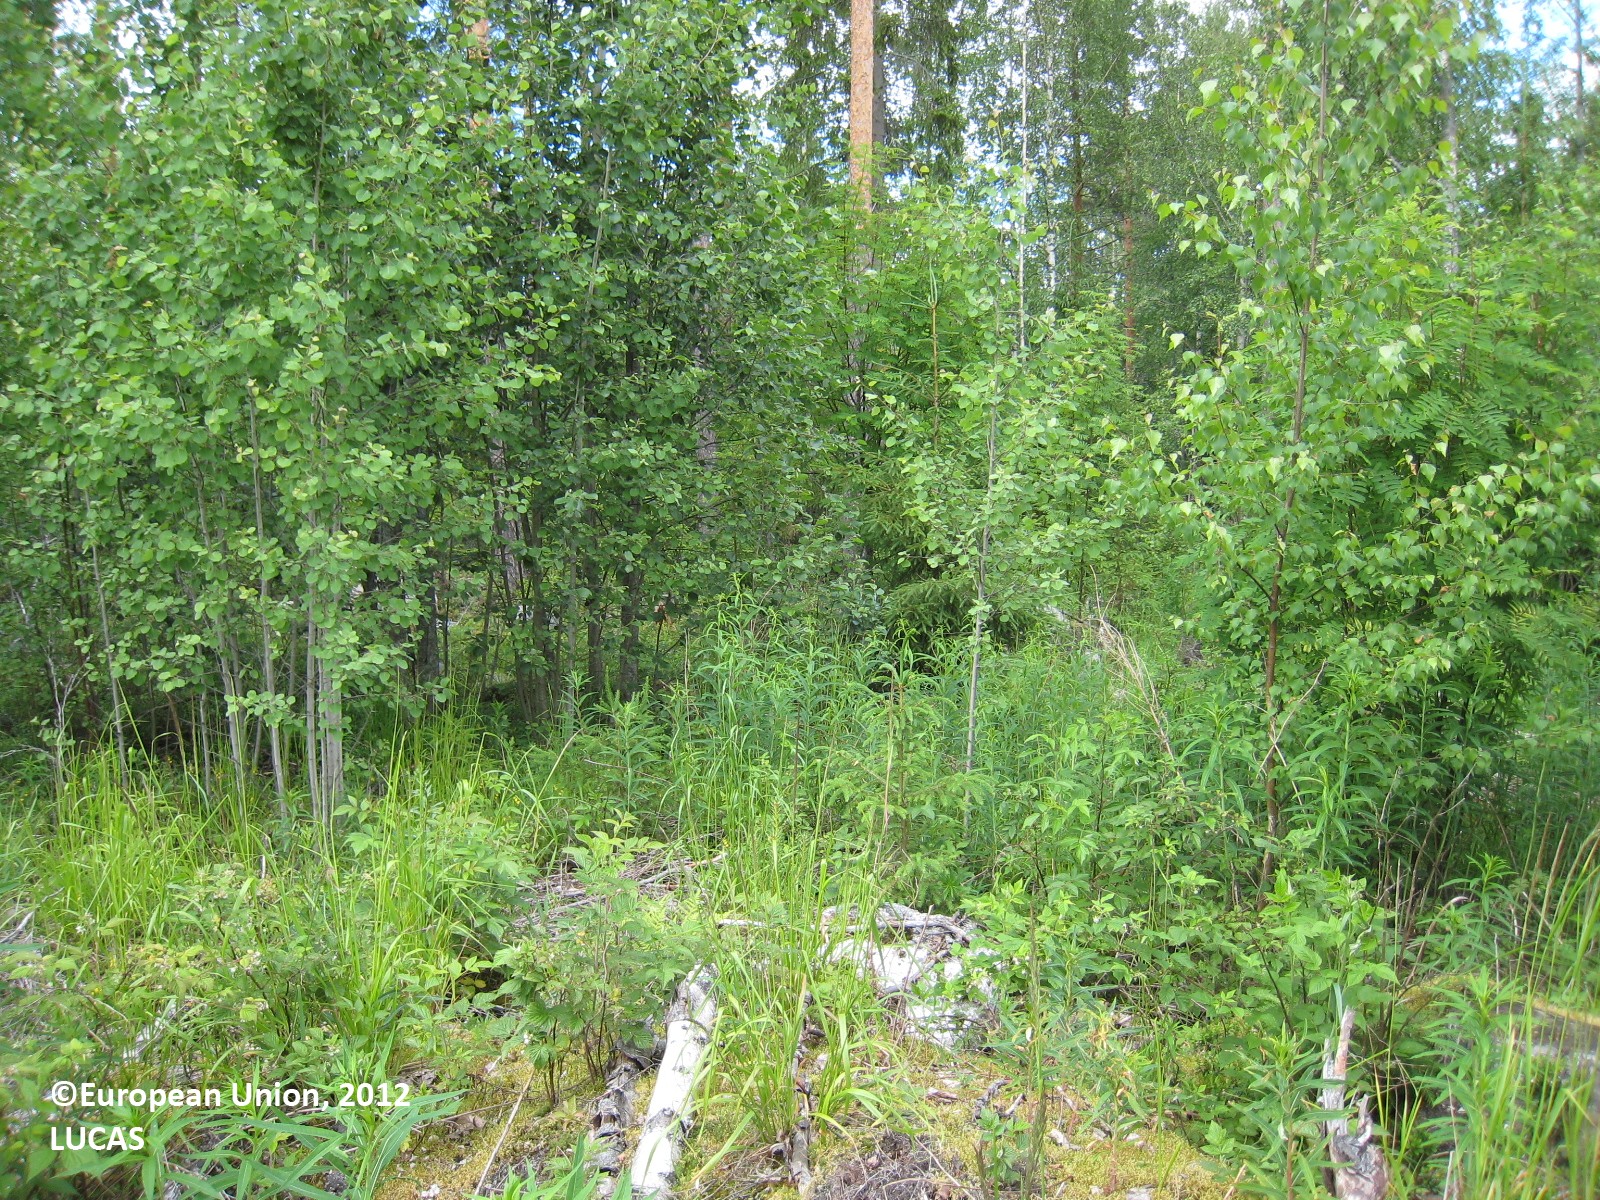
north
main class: Woodland
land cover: Spruce dominated mixed woodland
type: boreal forest
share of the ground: 50 - 75 %
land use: Forestry
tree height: > 5 m
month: June
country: FI
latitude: 61.9745
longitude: 25.7868
